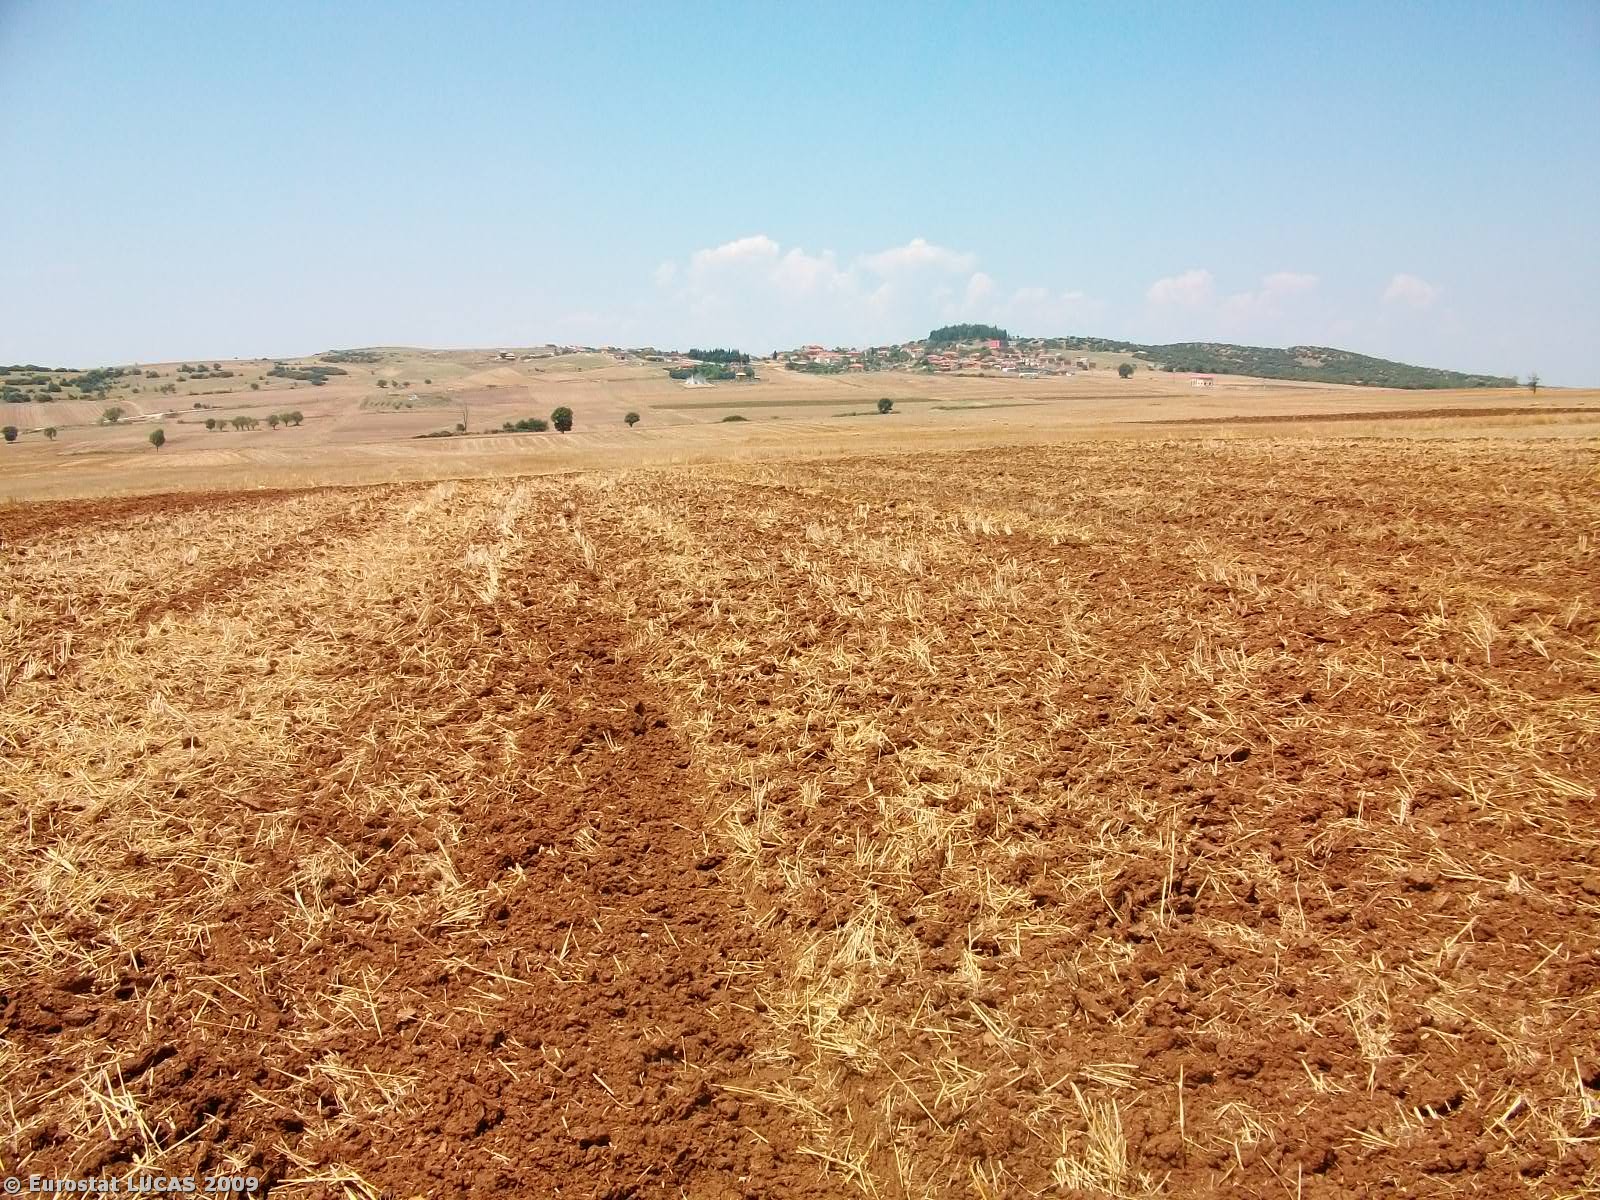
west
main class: Cropland
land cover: Common wheat
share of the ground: 25 - 50 %
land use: Agriculture (excluding fallow land and kitchen gardens)
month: July
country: GR
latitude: 40.8648
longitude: 22.9779
